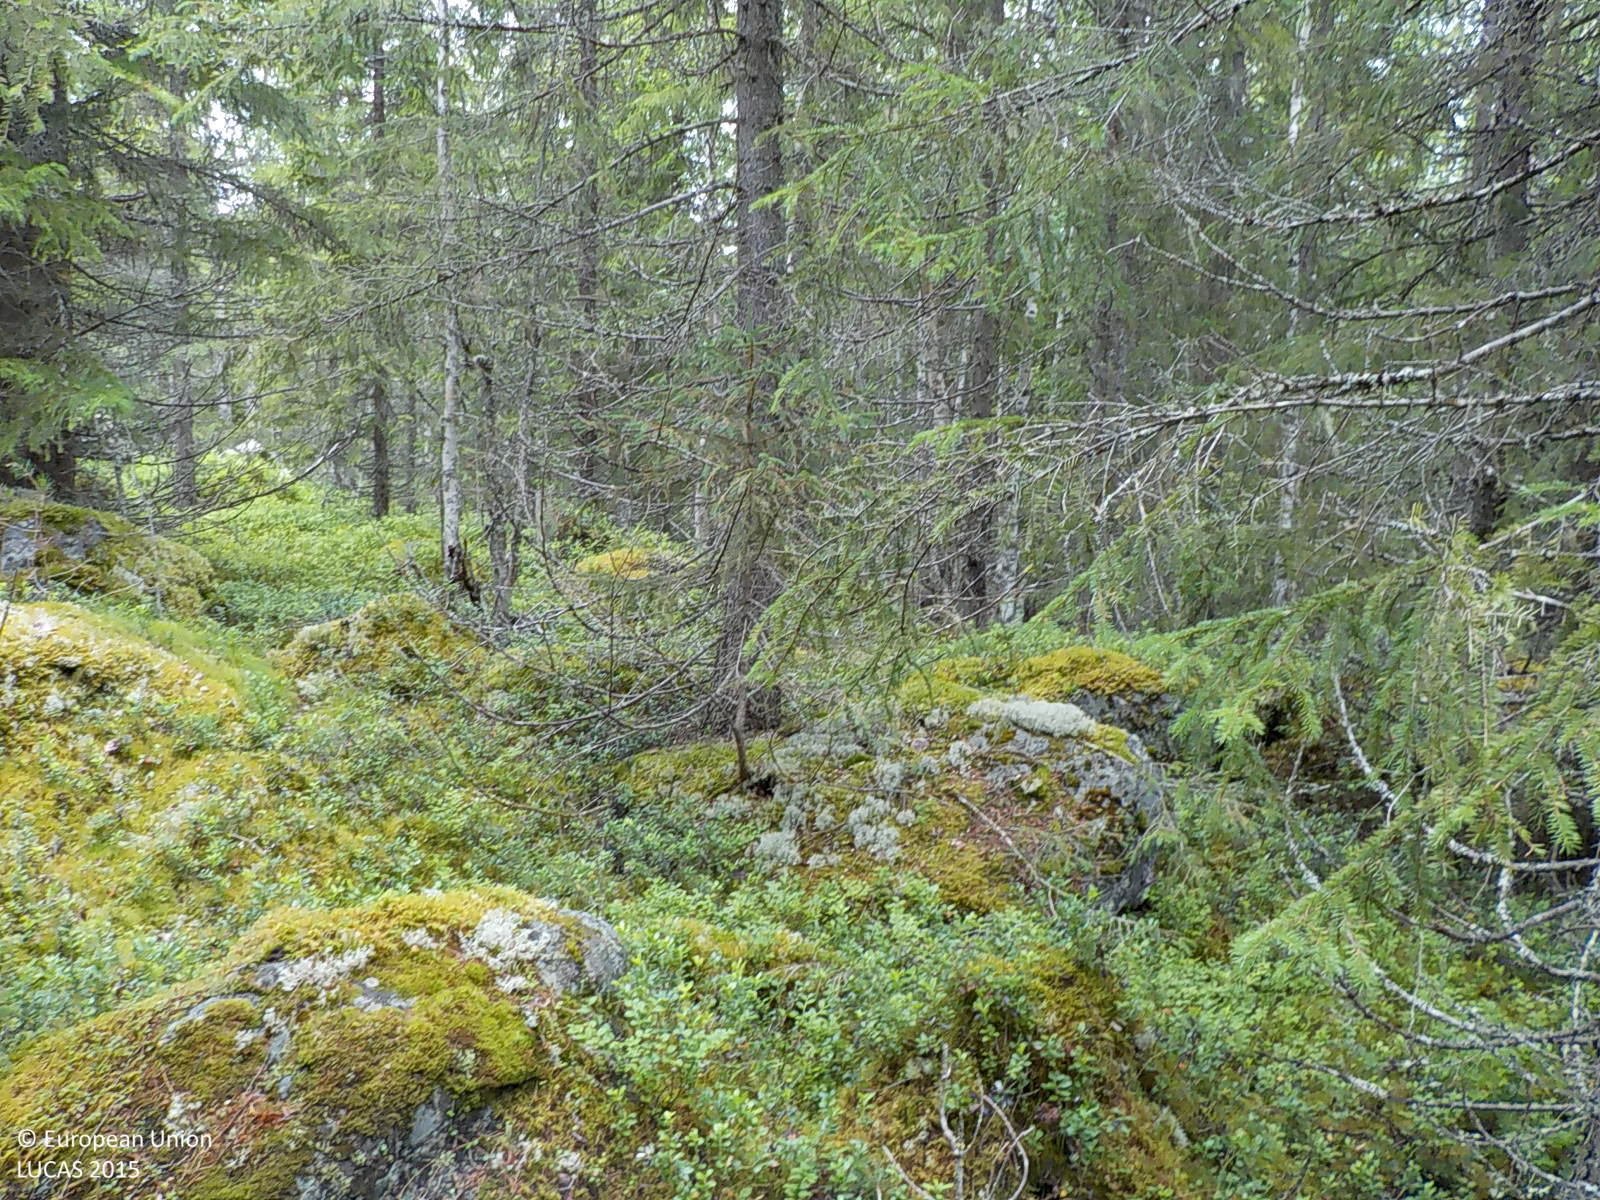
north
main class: Woodland
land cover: Other mixed woodland
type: boreal forest
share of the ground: > 75 %
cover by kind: coniferous forest trees 50 %, broadleaved forest trees 30 %, shrubs 10 %, lichens and mosses 5 %, consolidated bare surface 5 %
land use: Forestry
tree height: > 5 m
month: July
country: SE
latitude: 63.3430
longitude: 17.2668
